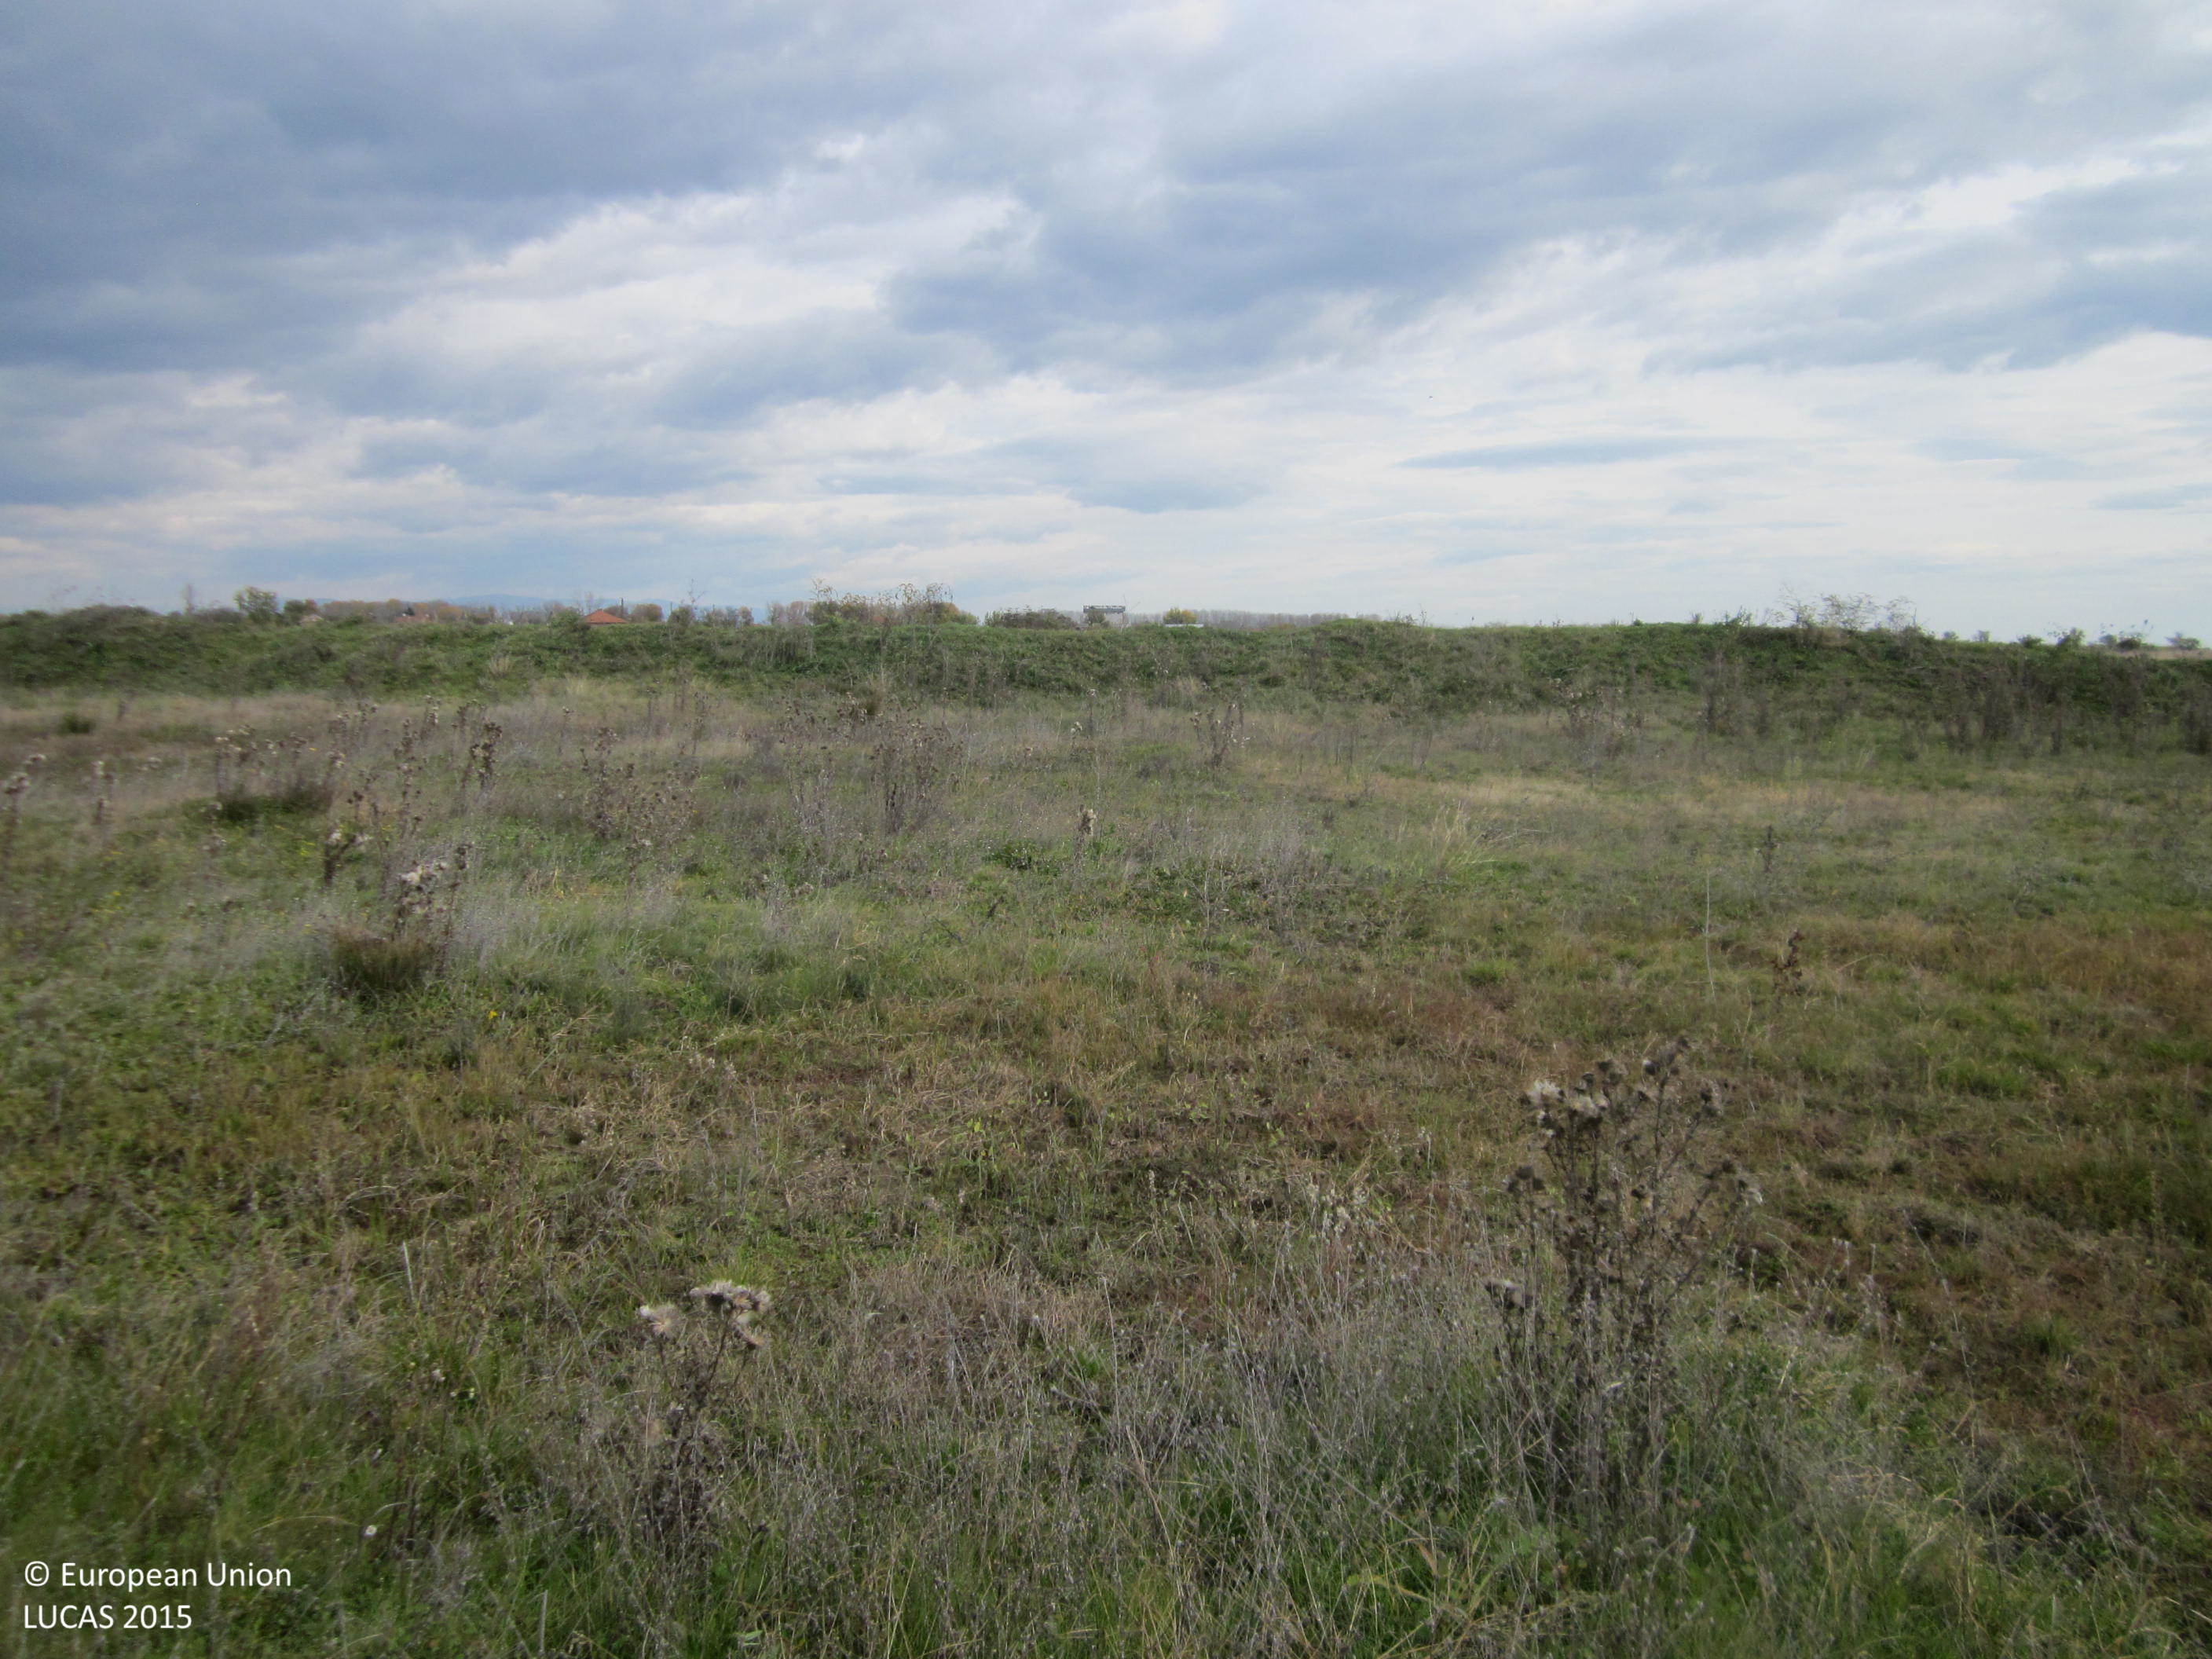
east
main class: Grassland
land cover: Grassland without tree/shrub cover
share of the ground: > 75 %
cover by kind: herbaceous plants 100 %
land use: Agriculture (excluding fallow land and kitchen gardens)
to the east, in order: Grassland without tree/shrub cover; Tracks; Grass margins; Ditches and canals; Grass margins; Ditches and canals; Grassland without tree/shrub cover
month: November
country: BG
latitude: 42.3402
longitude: 24.6042
